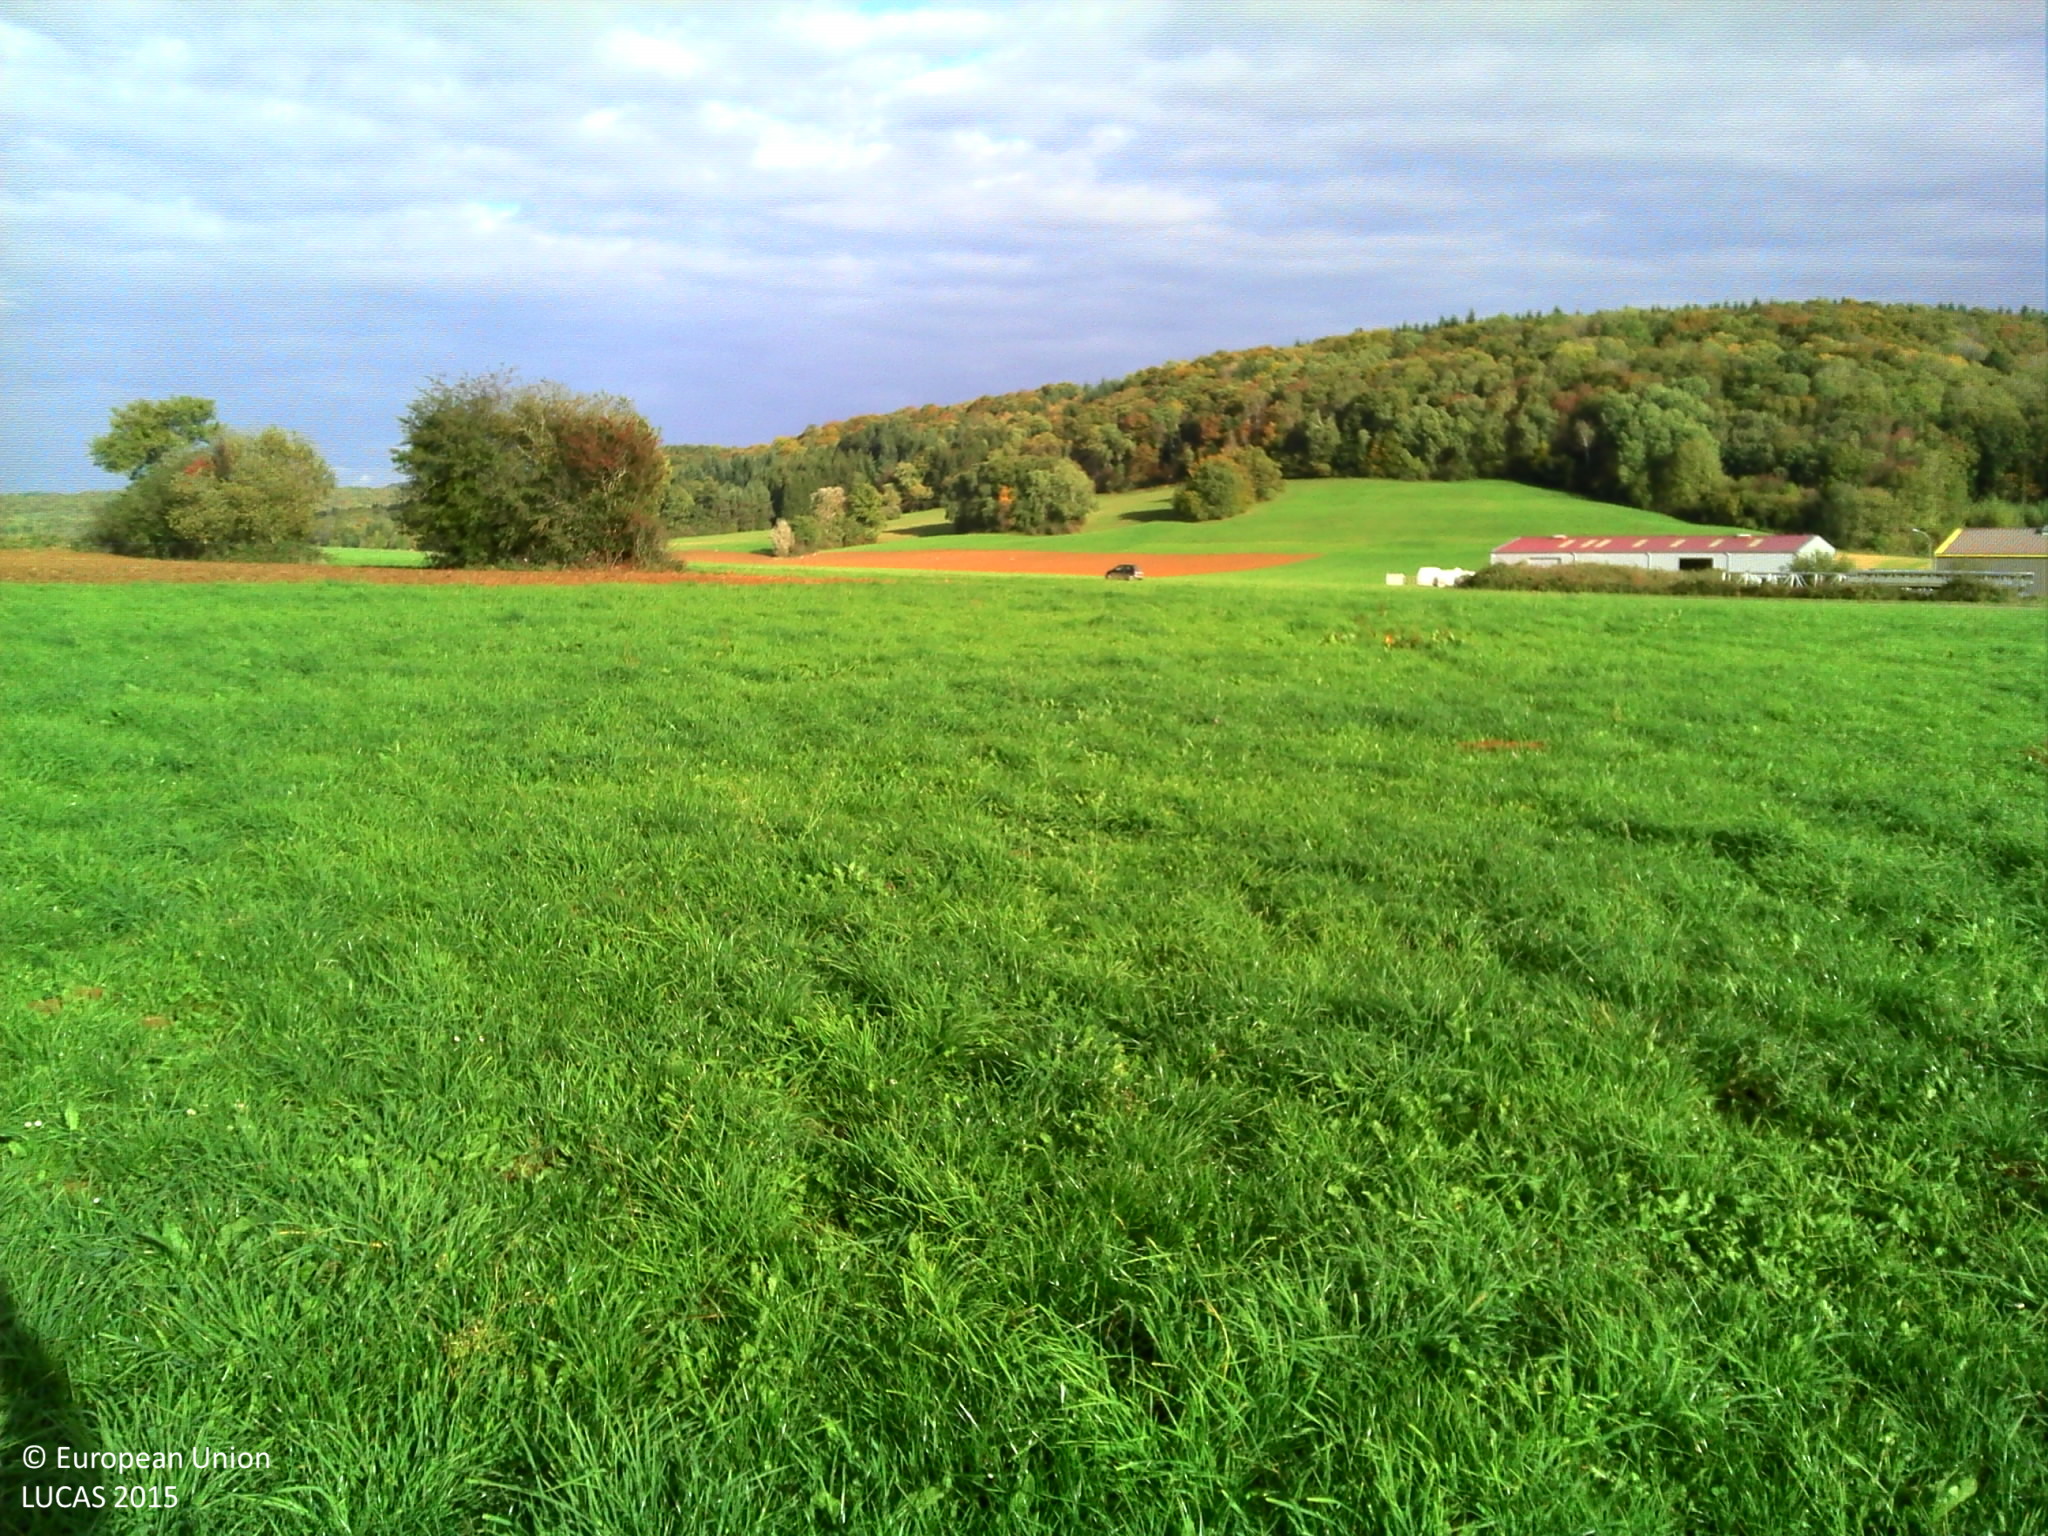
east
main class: Grassland
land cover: Grassland without tree/shrub cover
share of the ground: > 75 %
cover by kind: herbaceous plants 100 %
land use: Agriculture (excluding fallow land and kitchen gardens)
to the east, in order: Grassland without tree/shrub cover; Fences; Grass margins; Paved roads, cycling and walking lanes; Grassland without tree/shrub cover
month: October
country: FR
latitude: 47.1251
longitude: 6.0342
